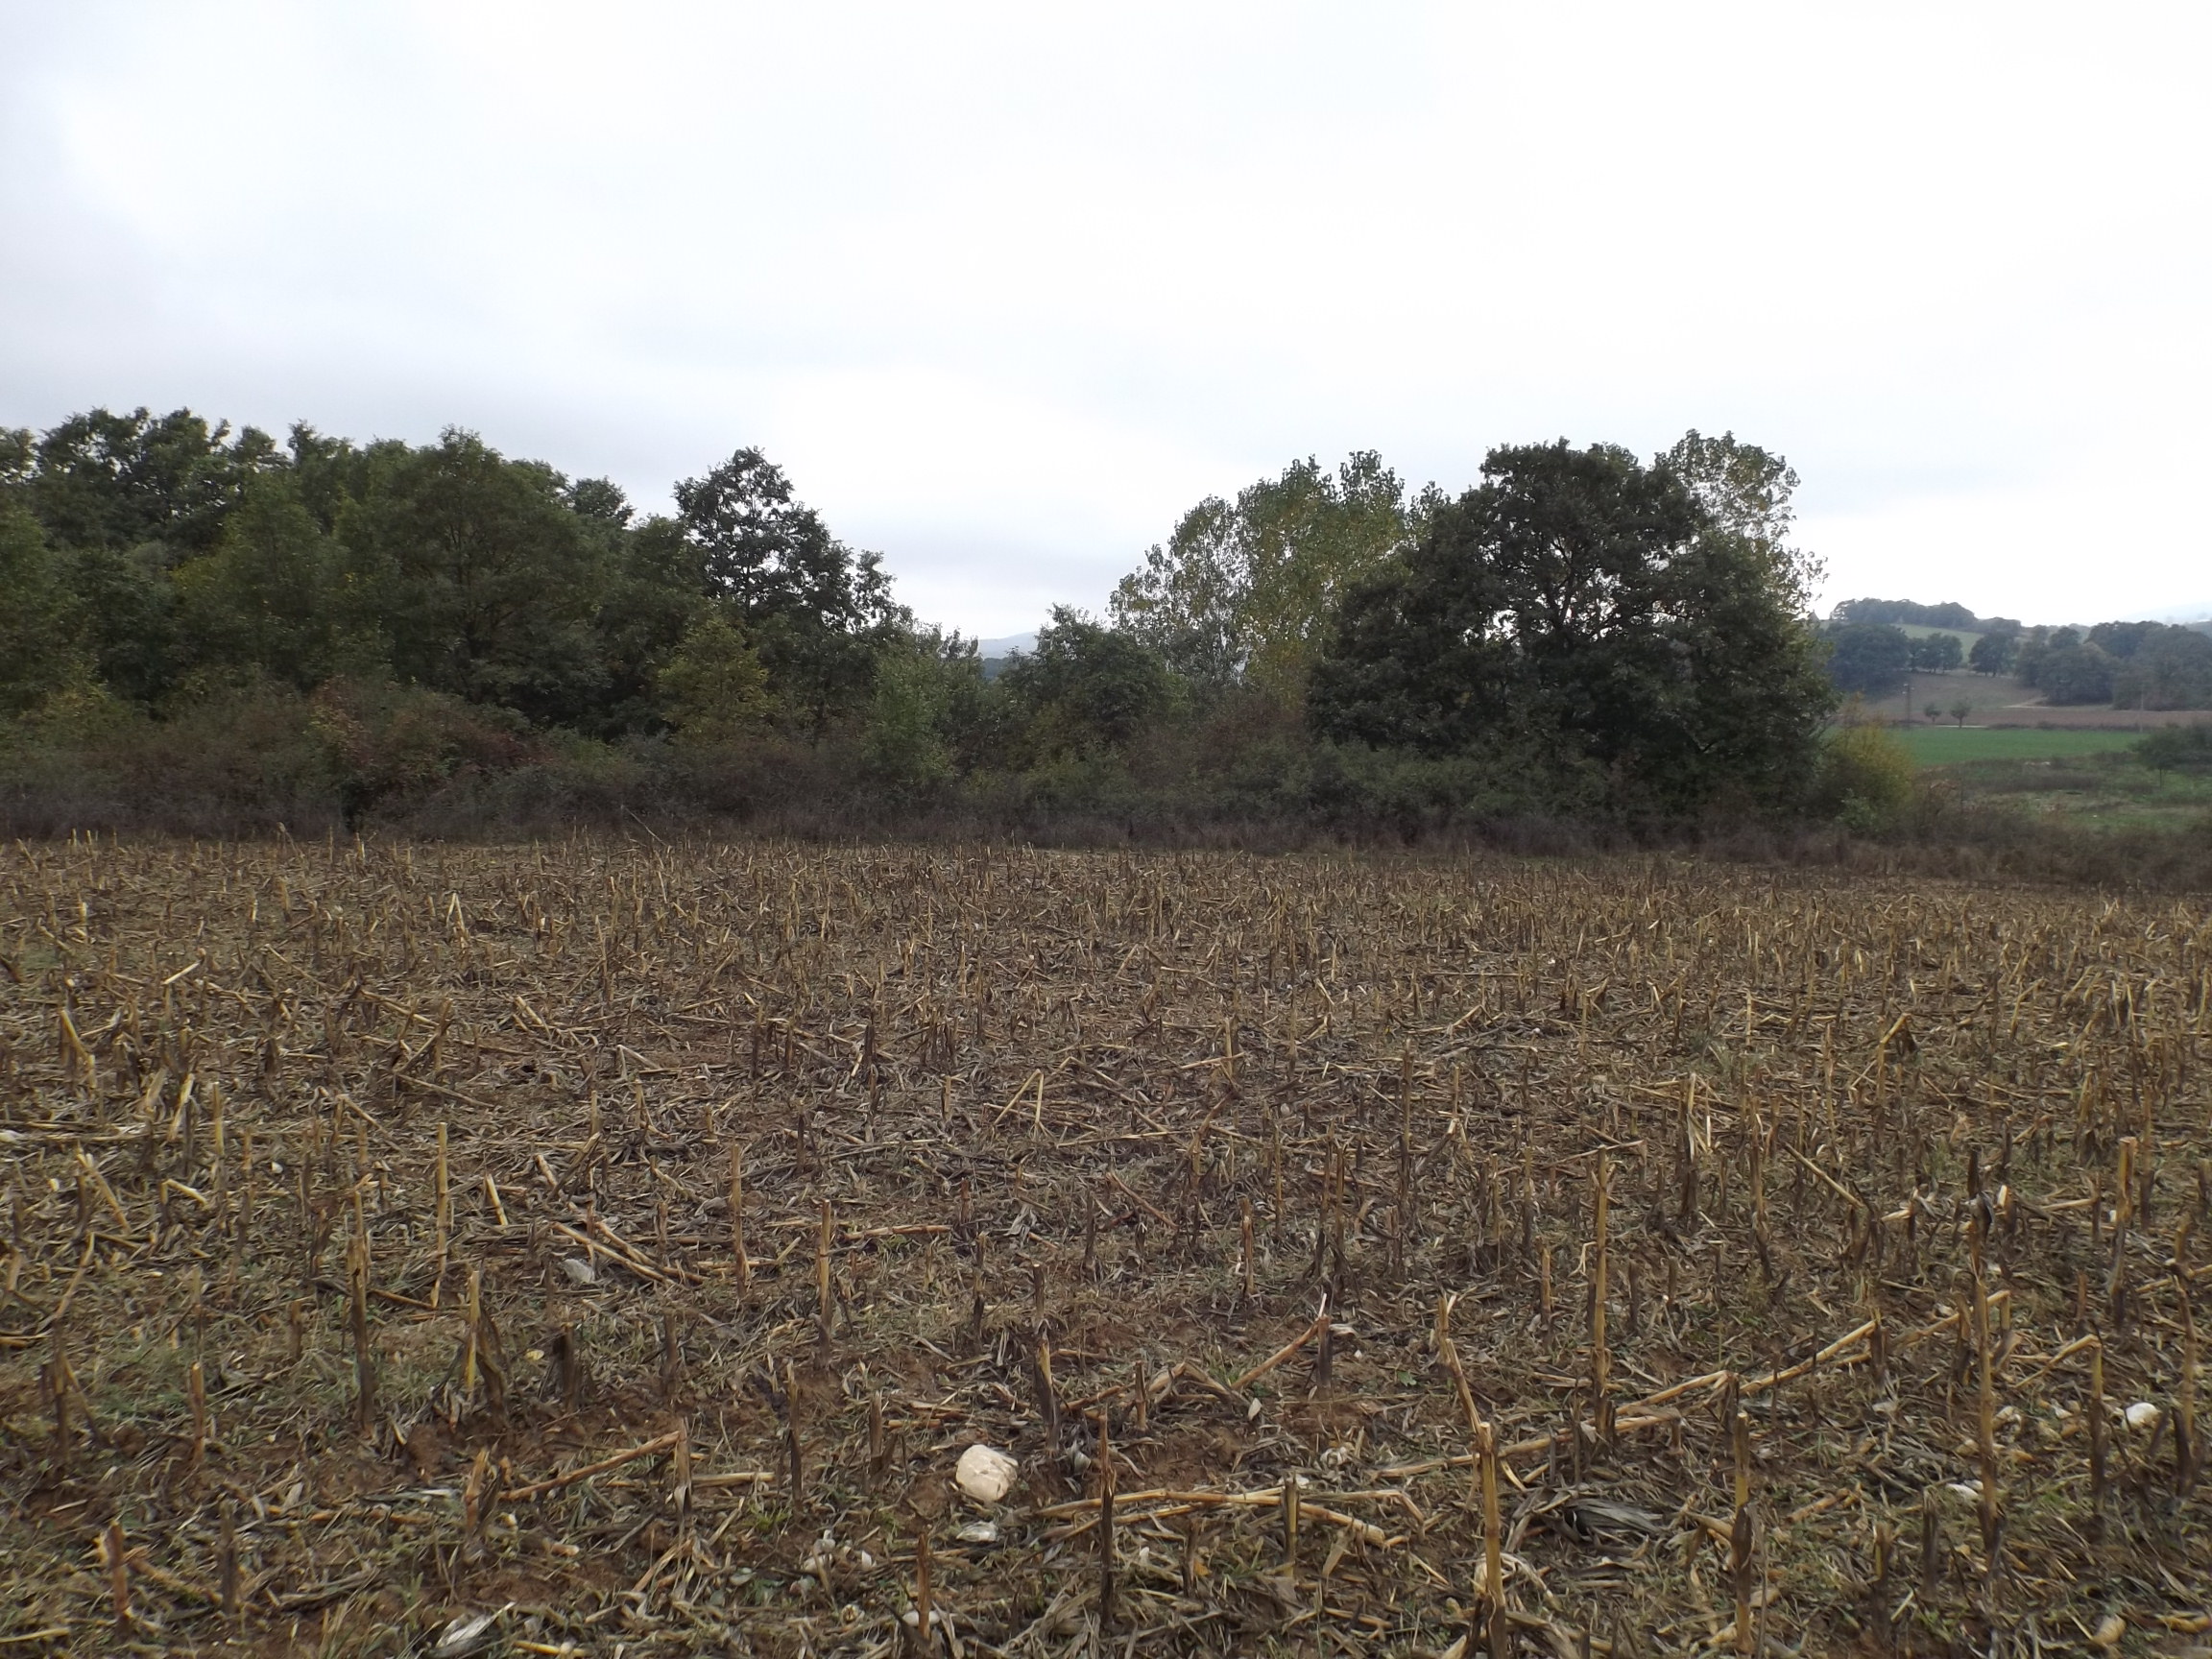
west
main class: Cropland
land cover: Maize
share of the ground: 10 - 25 %
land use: Agriculture (excluding fallow land and kitchen gardens)
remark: Harvested field
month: October
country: BG
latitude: 42.9969
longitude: 27.1780
